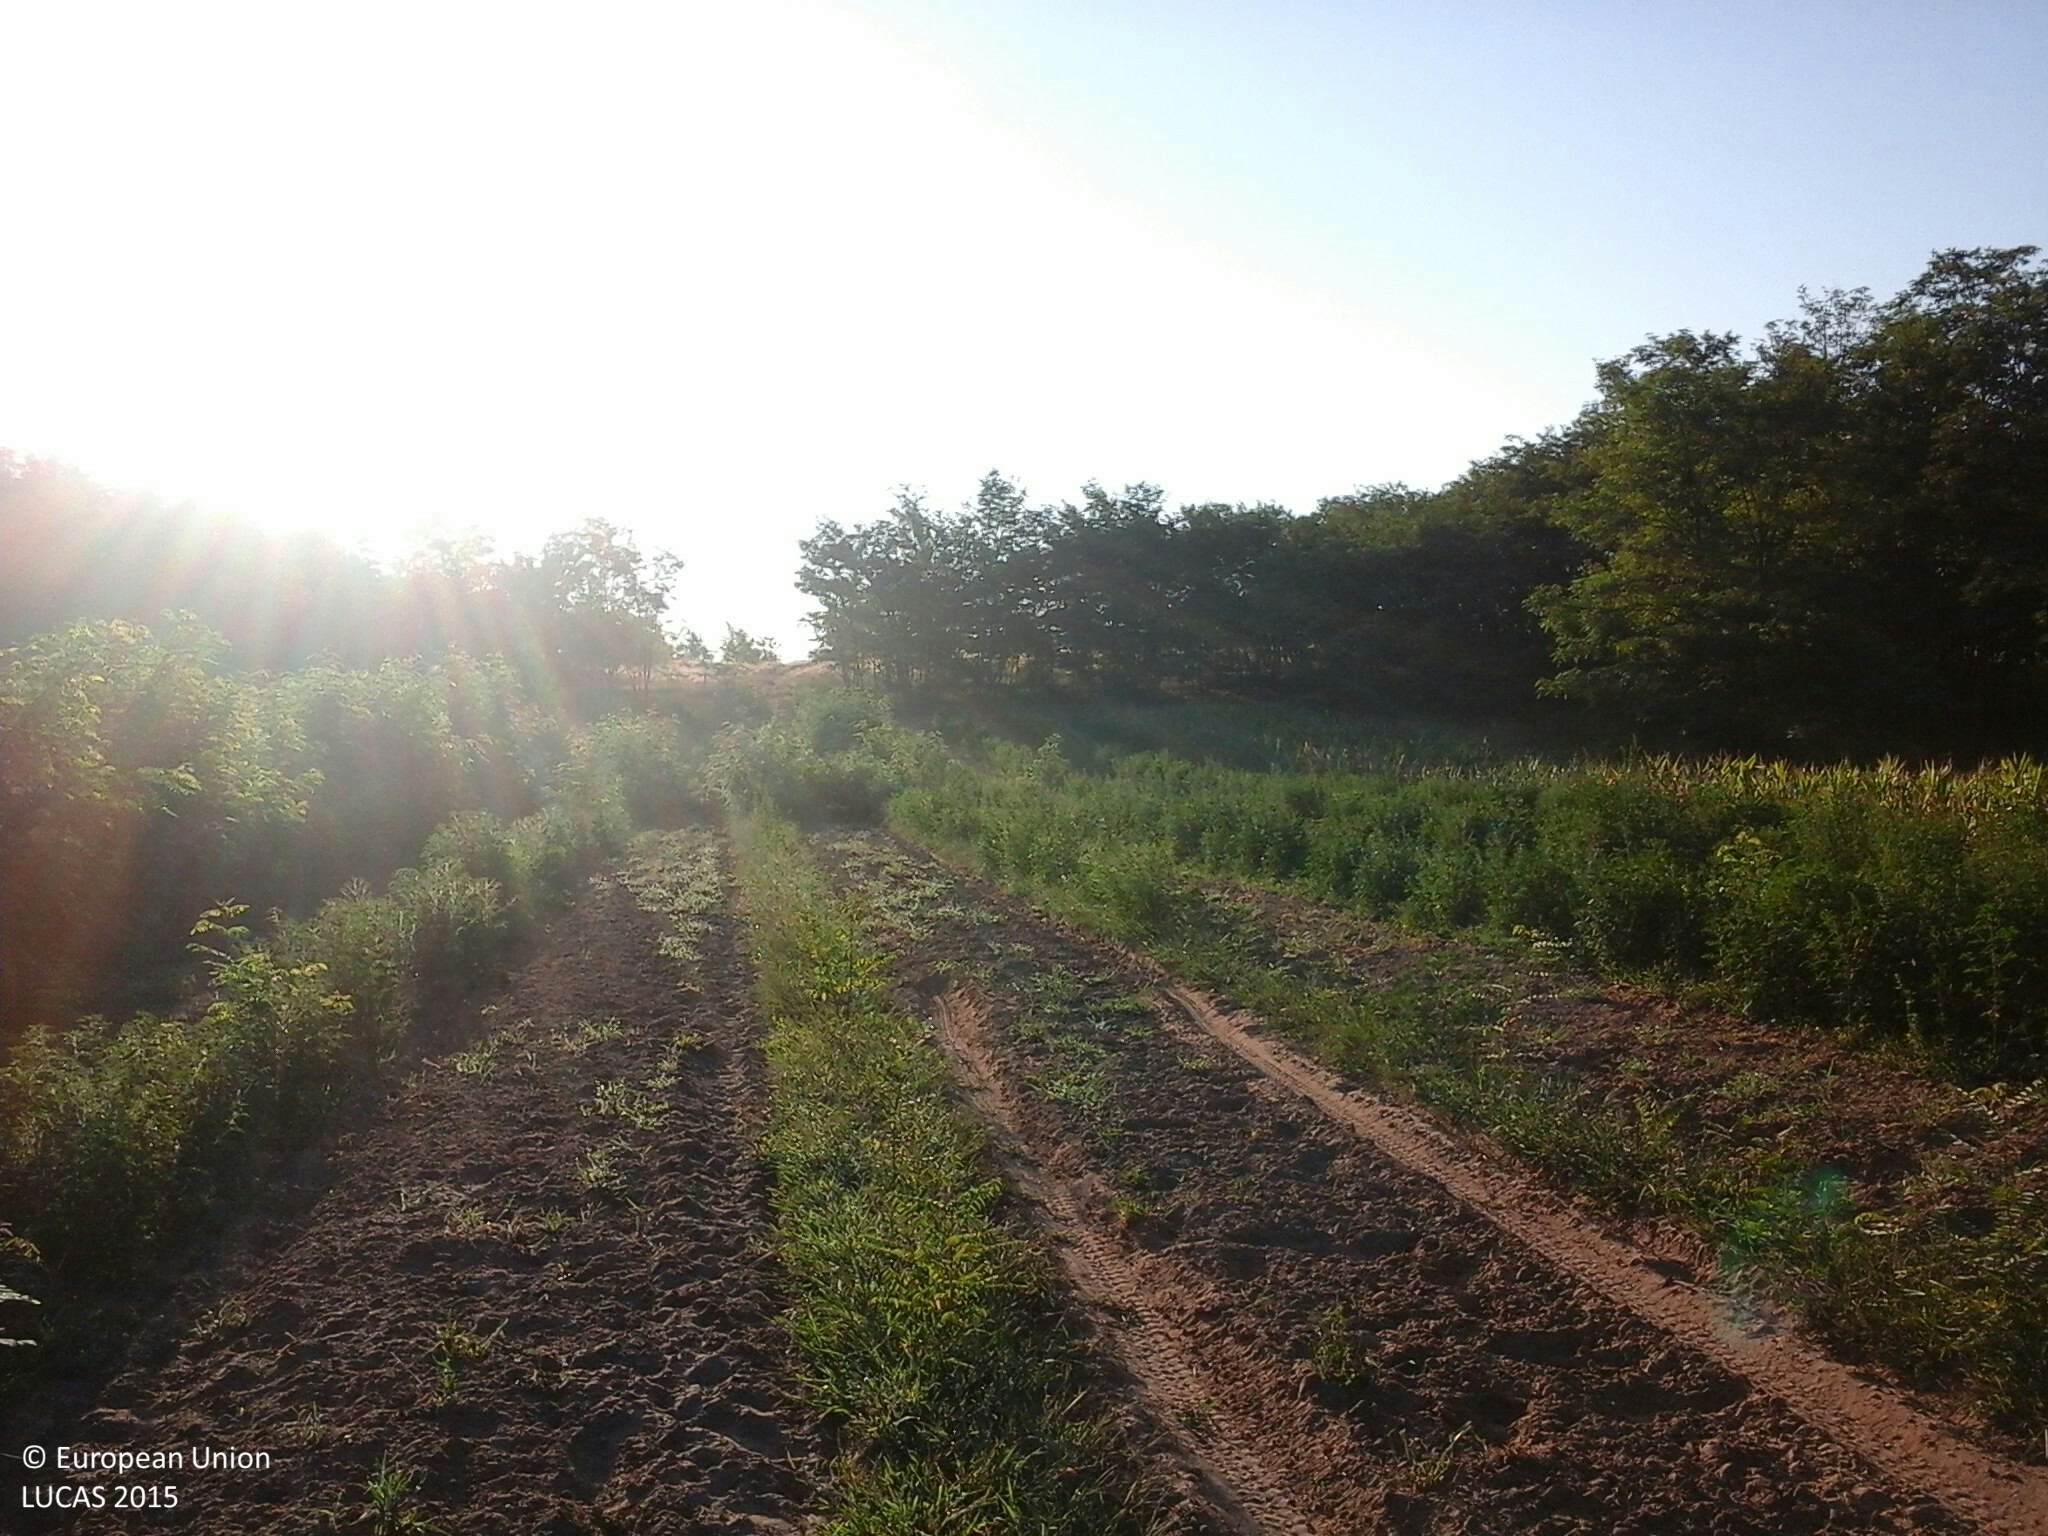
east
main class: Woodland
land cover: Broadleaved woodland
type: exotic forest
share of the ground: 25 - 50 %
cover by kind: unconsolidated bare surface 50 %, broadleaved forest trees 40 %, herbaceous plants 10 %
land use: Forestry
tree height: < 5 m
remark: Nursery
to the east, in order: Broadleaved woodland; Tracks; Broadleaved woodland; Grassland with sparse tree/shrub cover; Broadleaved woodland; Sunflower
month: July
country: HU
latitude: 47.6985
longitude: 22.1116
